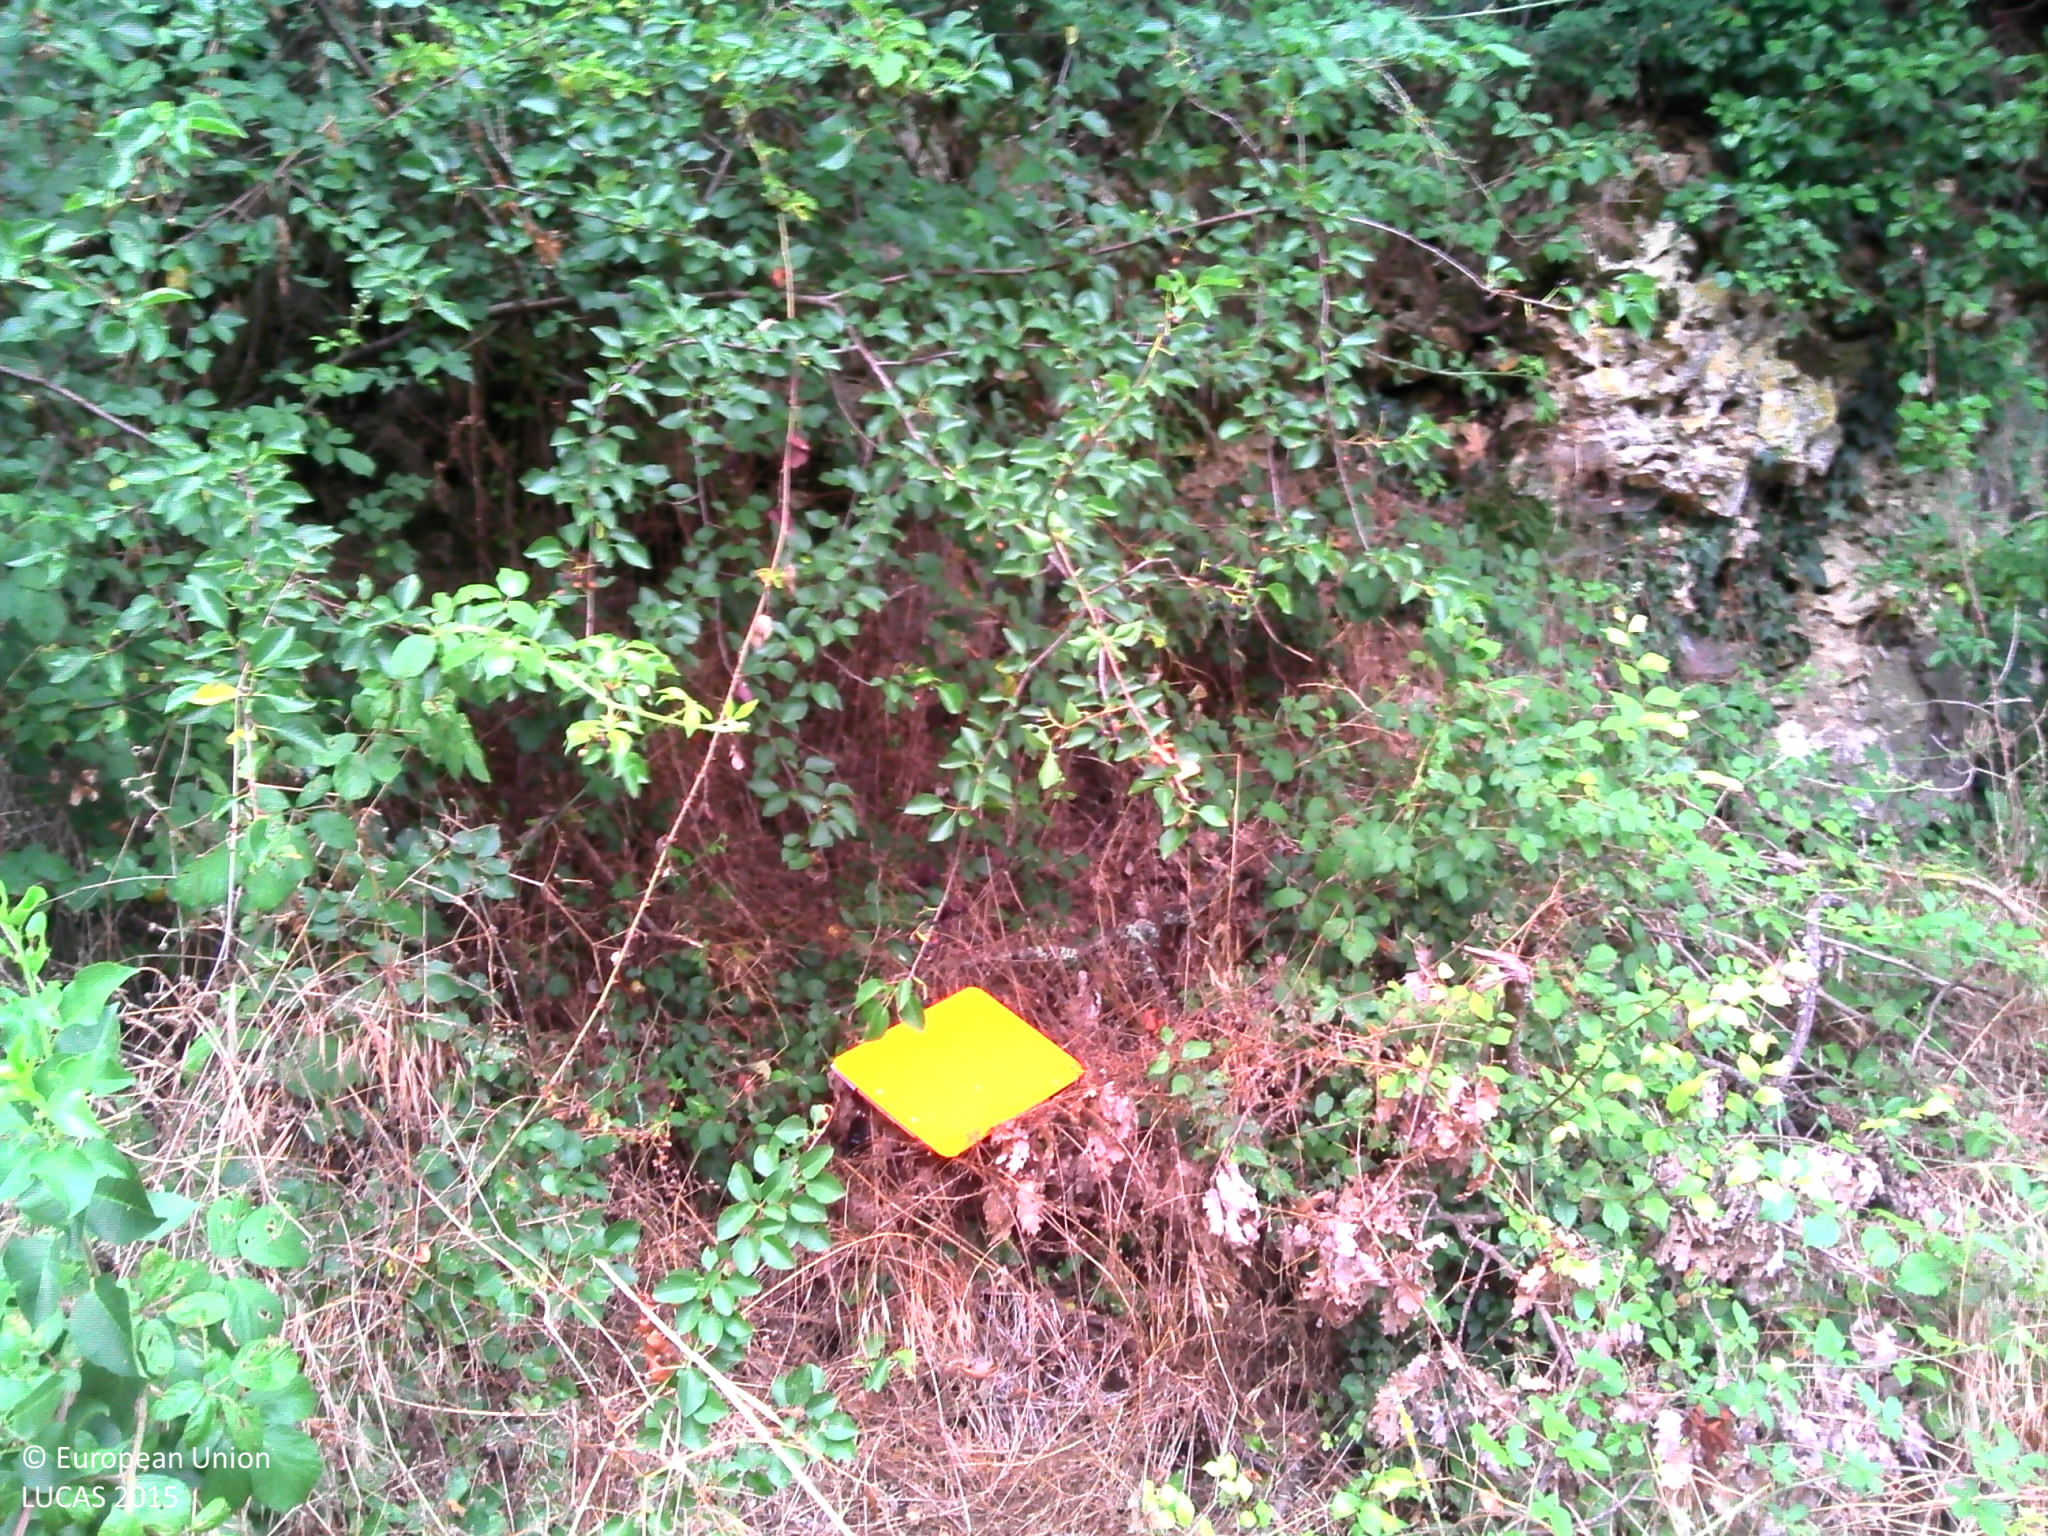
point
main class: Woodland
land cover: Broadleaved woodland
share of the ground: > 75 %
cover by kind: broadleaved forest trees 95 %, shrubs 5 %
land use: Agriculture (excluding fallow land and kitchen gardens)
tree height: > 5 m
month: July
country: FR
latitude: 44.2889
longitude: 0.8348
